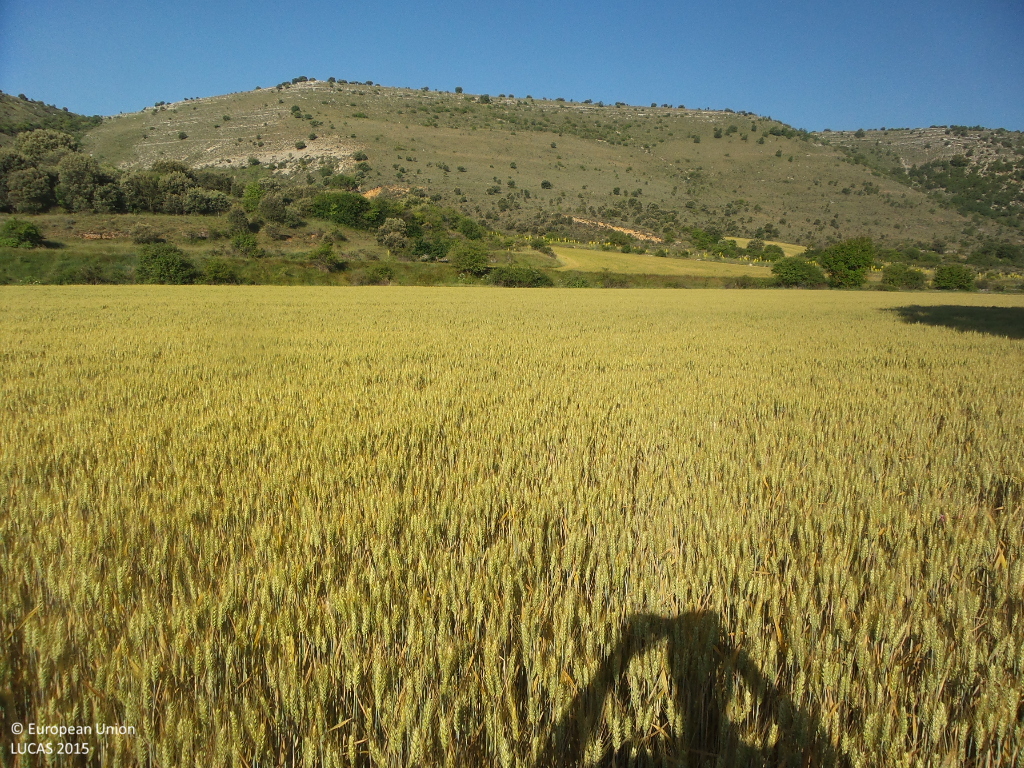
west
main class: Cropland
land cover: Common wheat
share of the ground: > 75 %
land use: Agriculture (excluding fallow land and kitchen gardens)
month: June
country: ES
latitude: 41.3733
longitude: -2.7222
